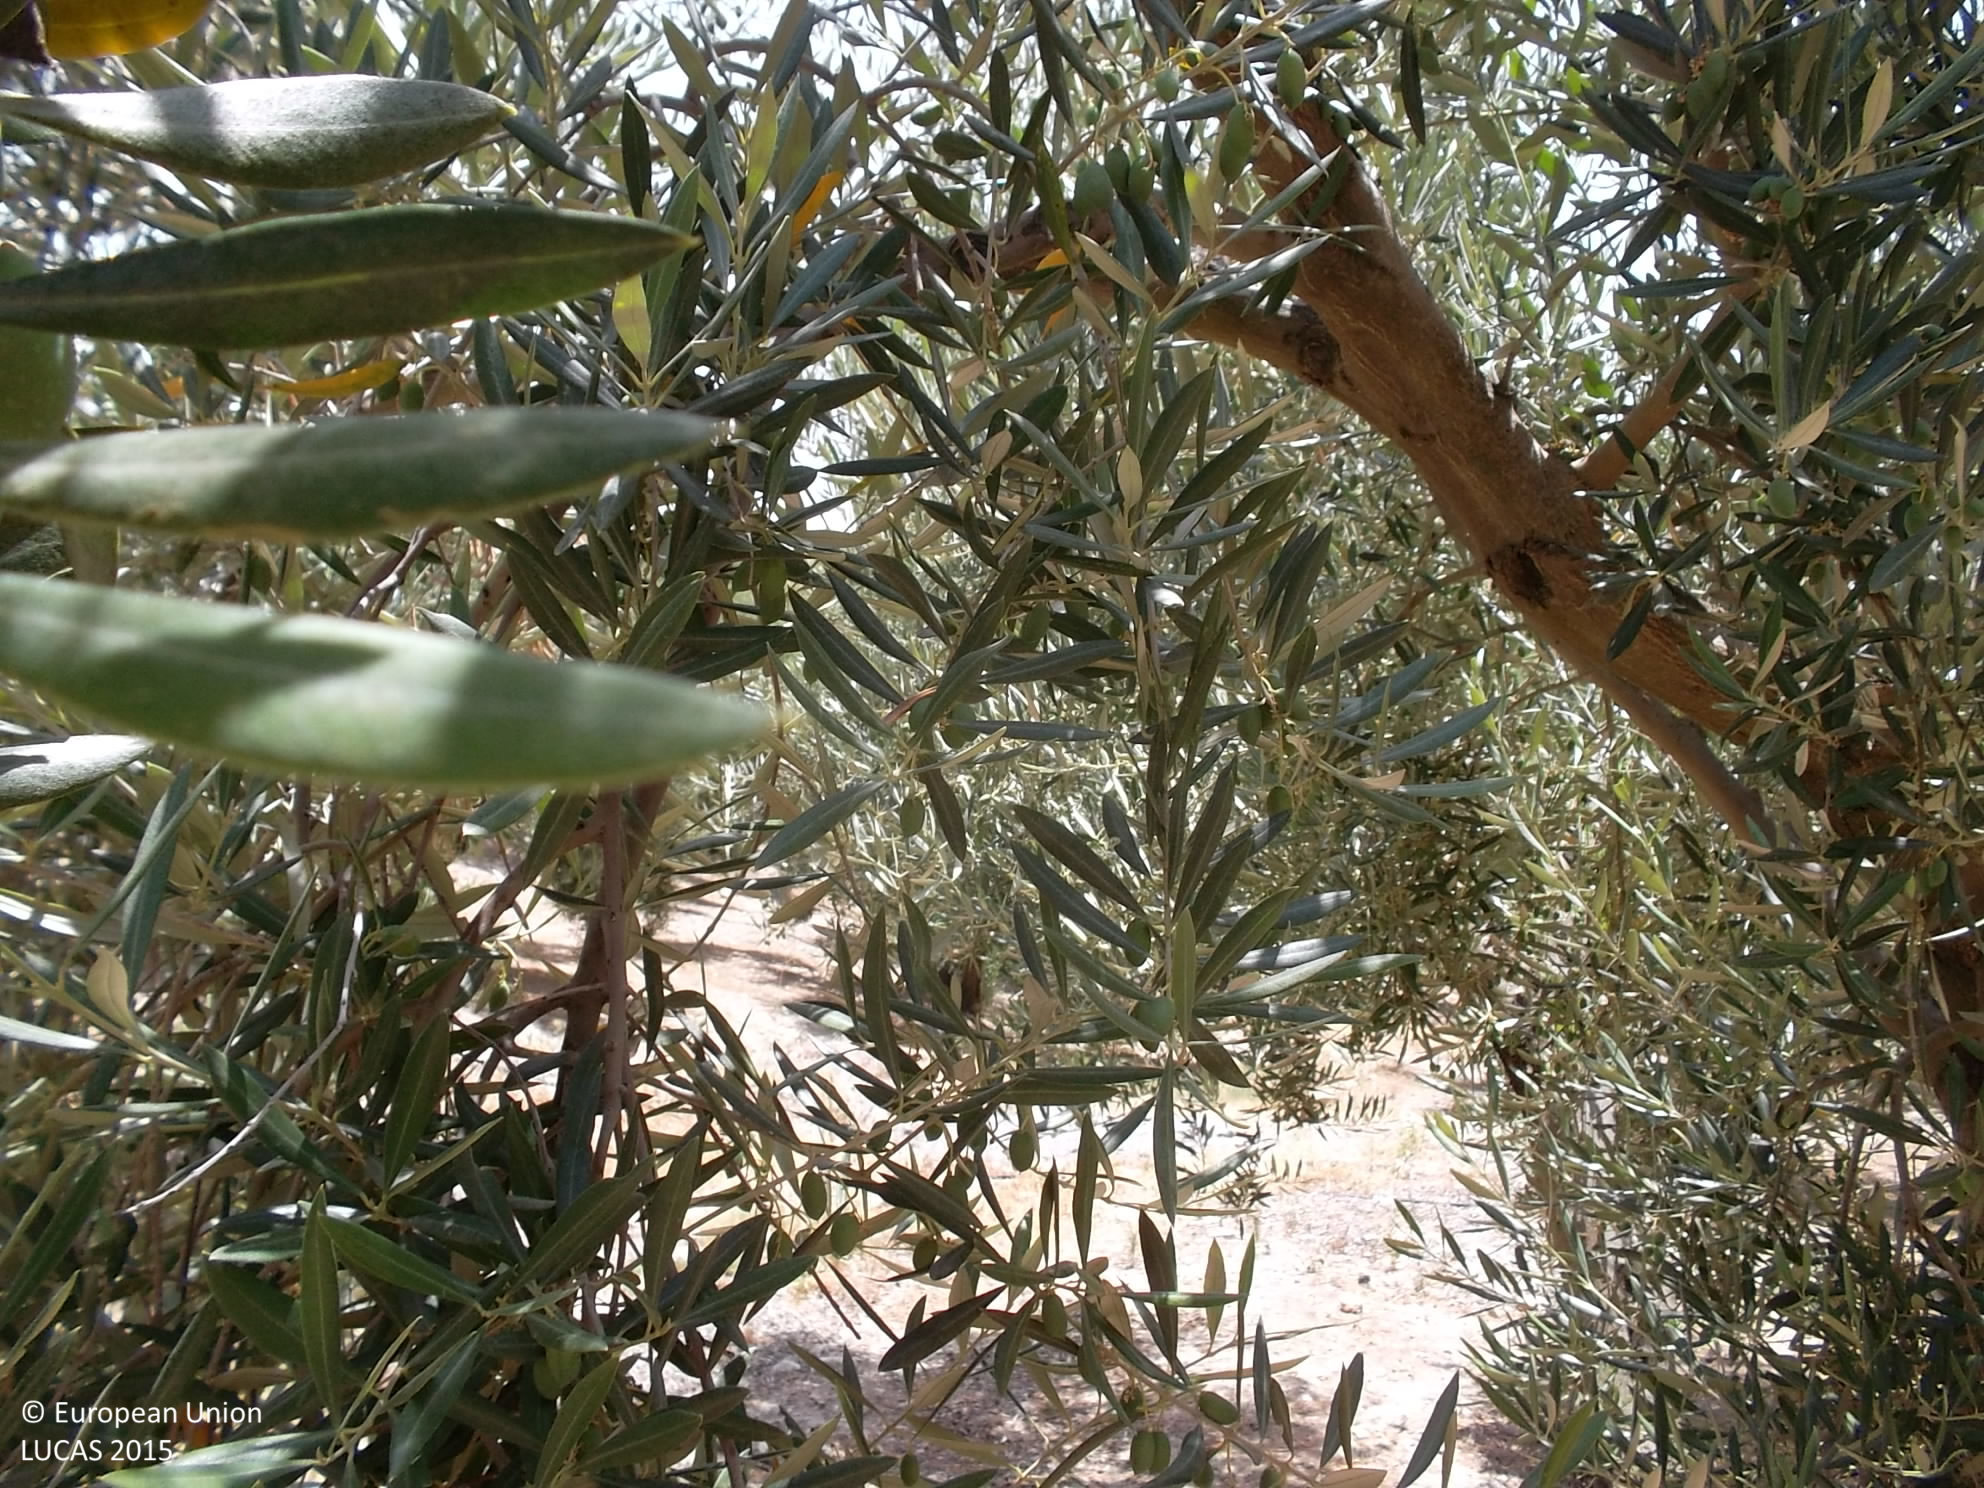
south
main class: Cropland
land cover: Olive groves
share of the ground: 25 - 50 %
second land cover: Spontaneously vegetated surfaces
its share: > 75 %
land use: Agriculture (excluding fallow land and kitchen gardens)
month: June
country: ES
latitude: 37.7452
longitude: -3.0327
